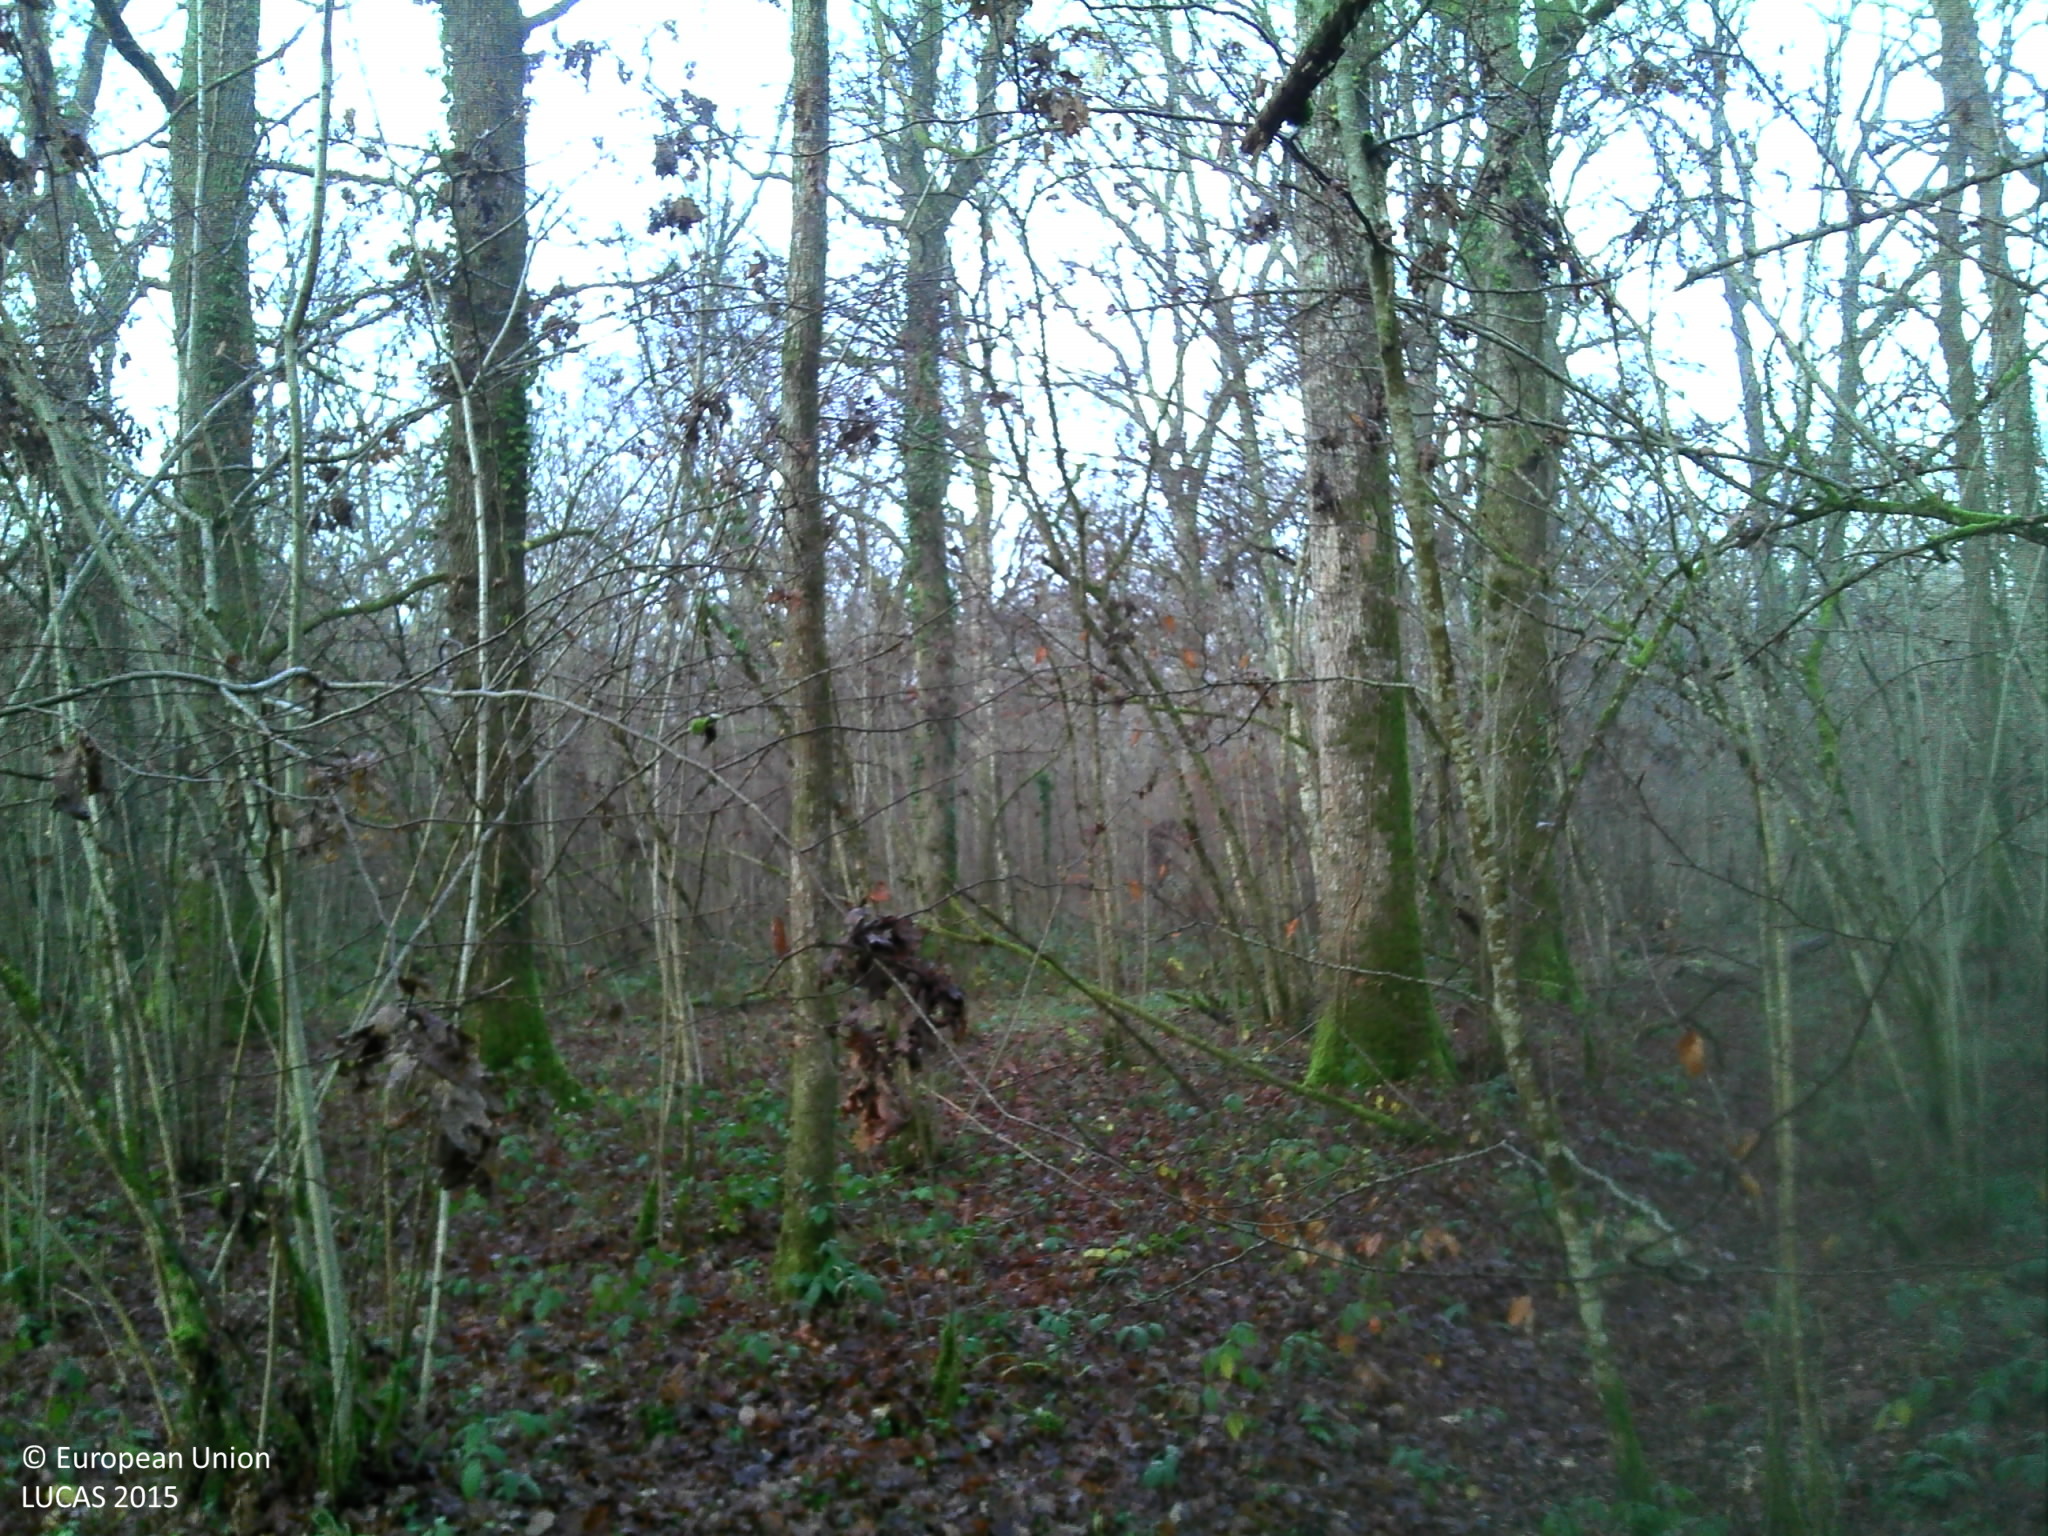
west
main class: Woodland
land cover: Broadleaved woodland
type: mesophytic deciduous forest
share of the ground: > 75 %
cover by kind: broadleaved forest trees 100 %
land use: Forestry
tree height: > 5 m
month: December
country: FR
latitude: 47.0132
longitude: 5.0682
